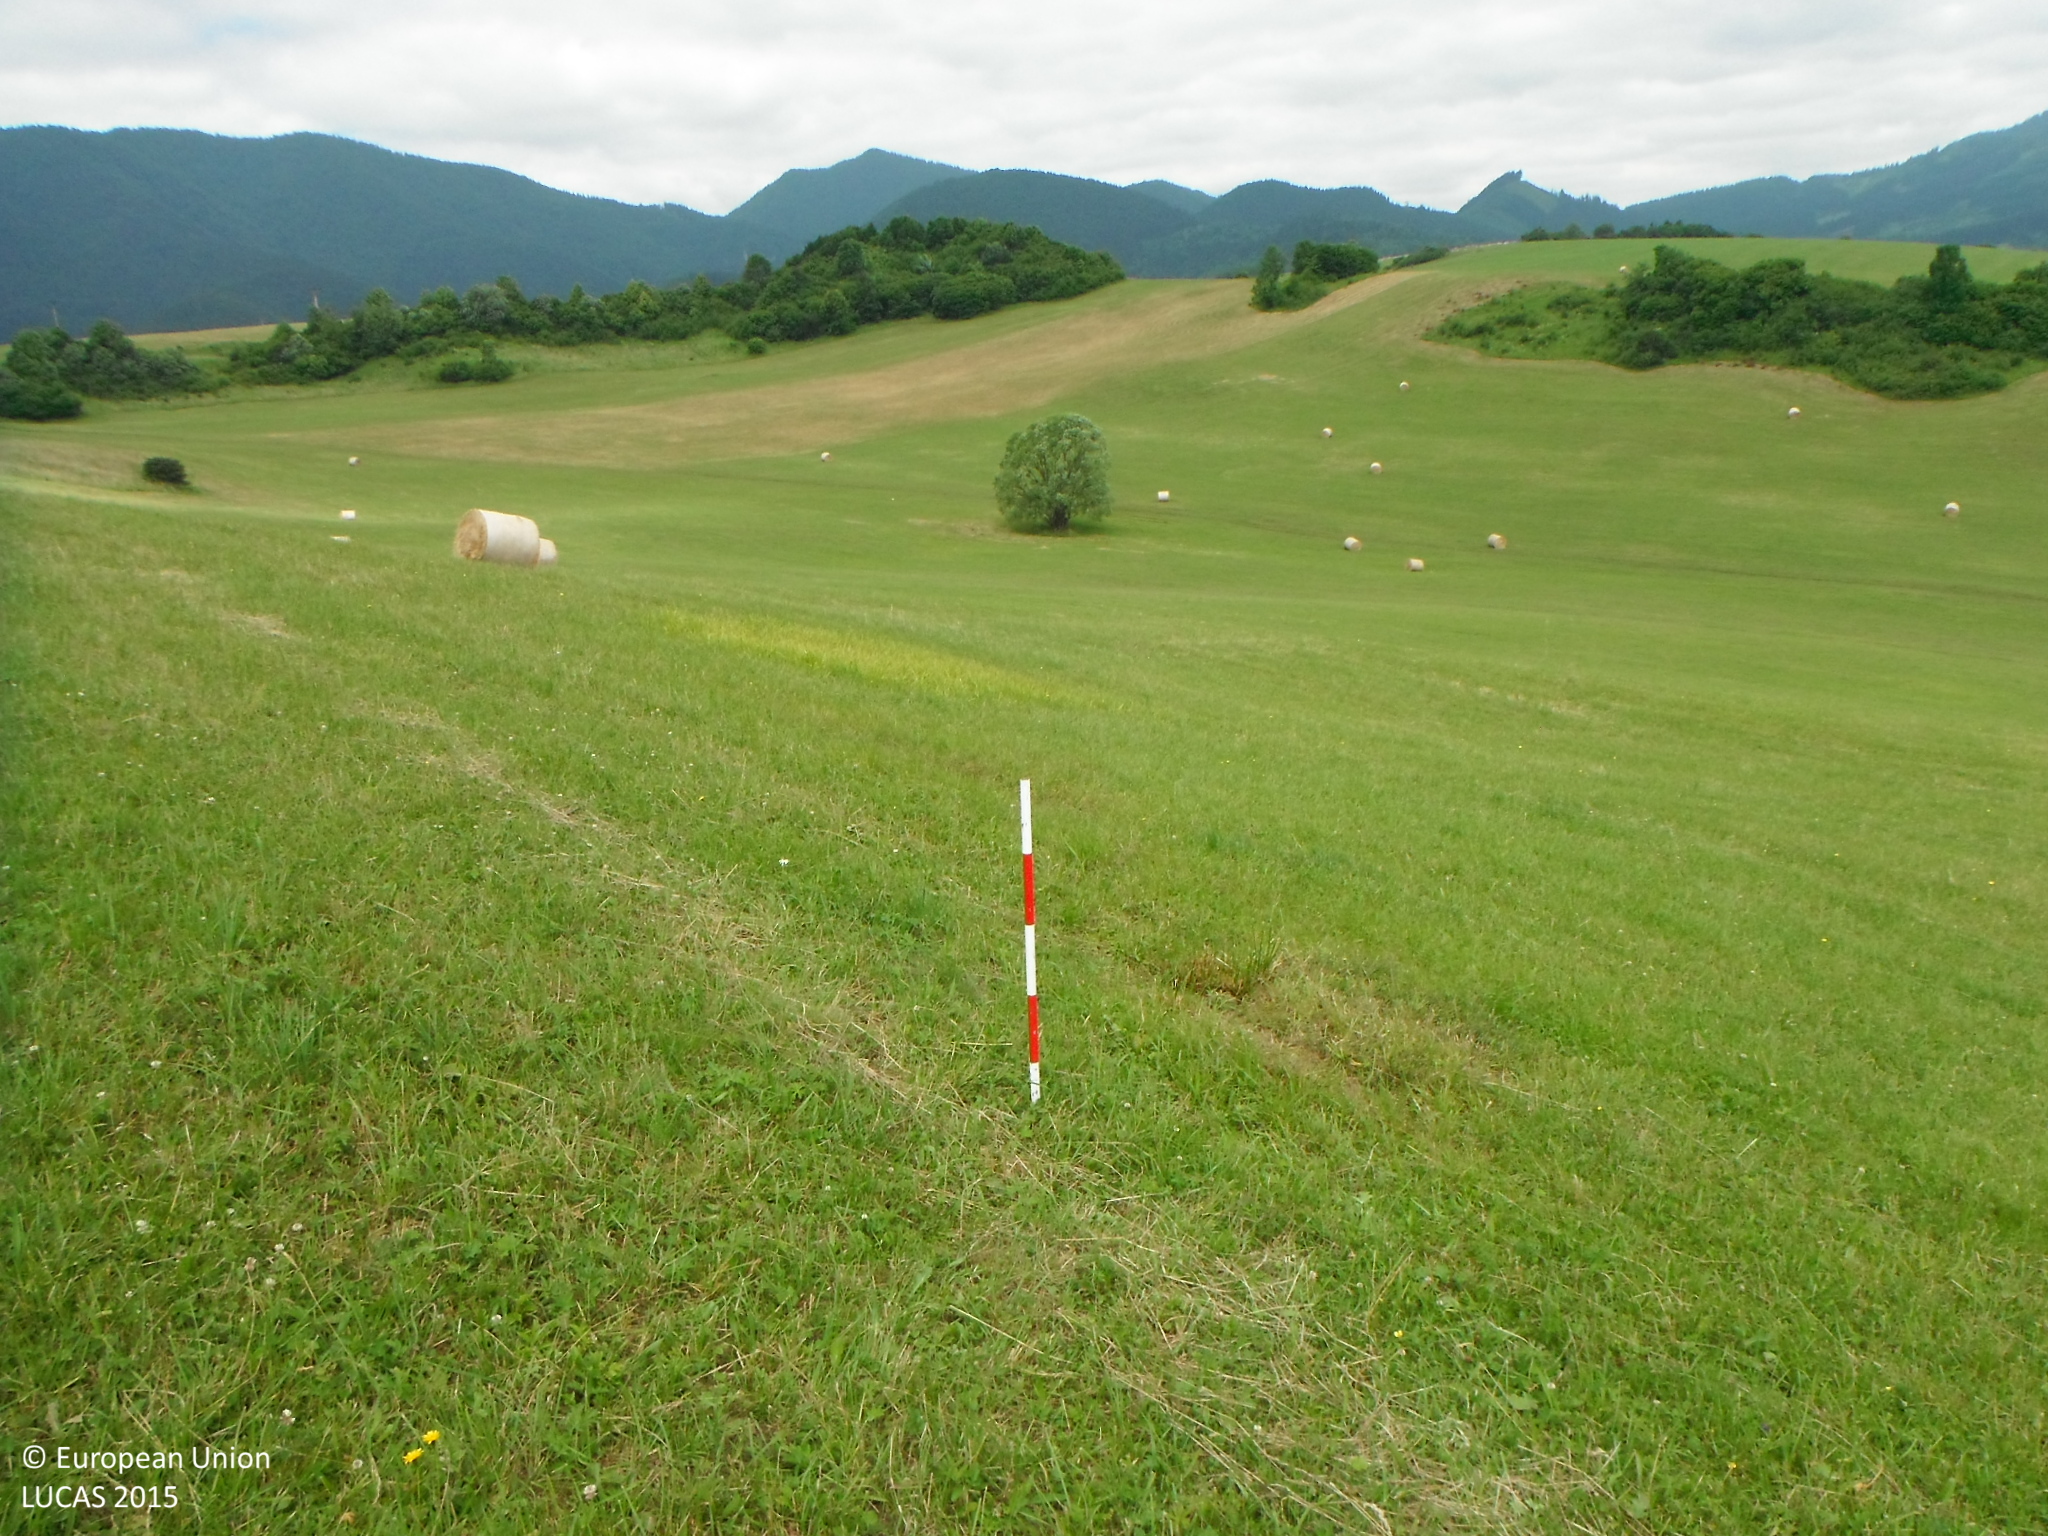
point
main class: Grassland
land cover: Grassland without tree/shrub cover
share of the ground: > 75 %
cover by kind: herbaceous plants 100 %
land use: Agriculture (excluding fallow land and kitchen gardens)
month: June
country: SK
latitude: 49.2114
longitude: 19.2349
